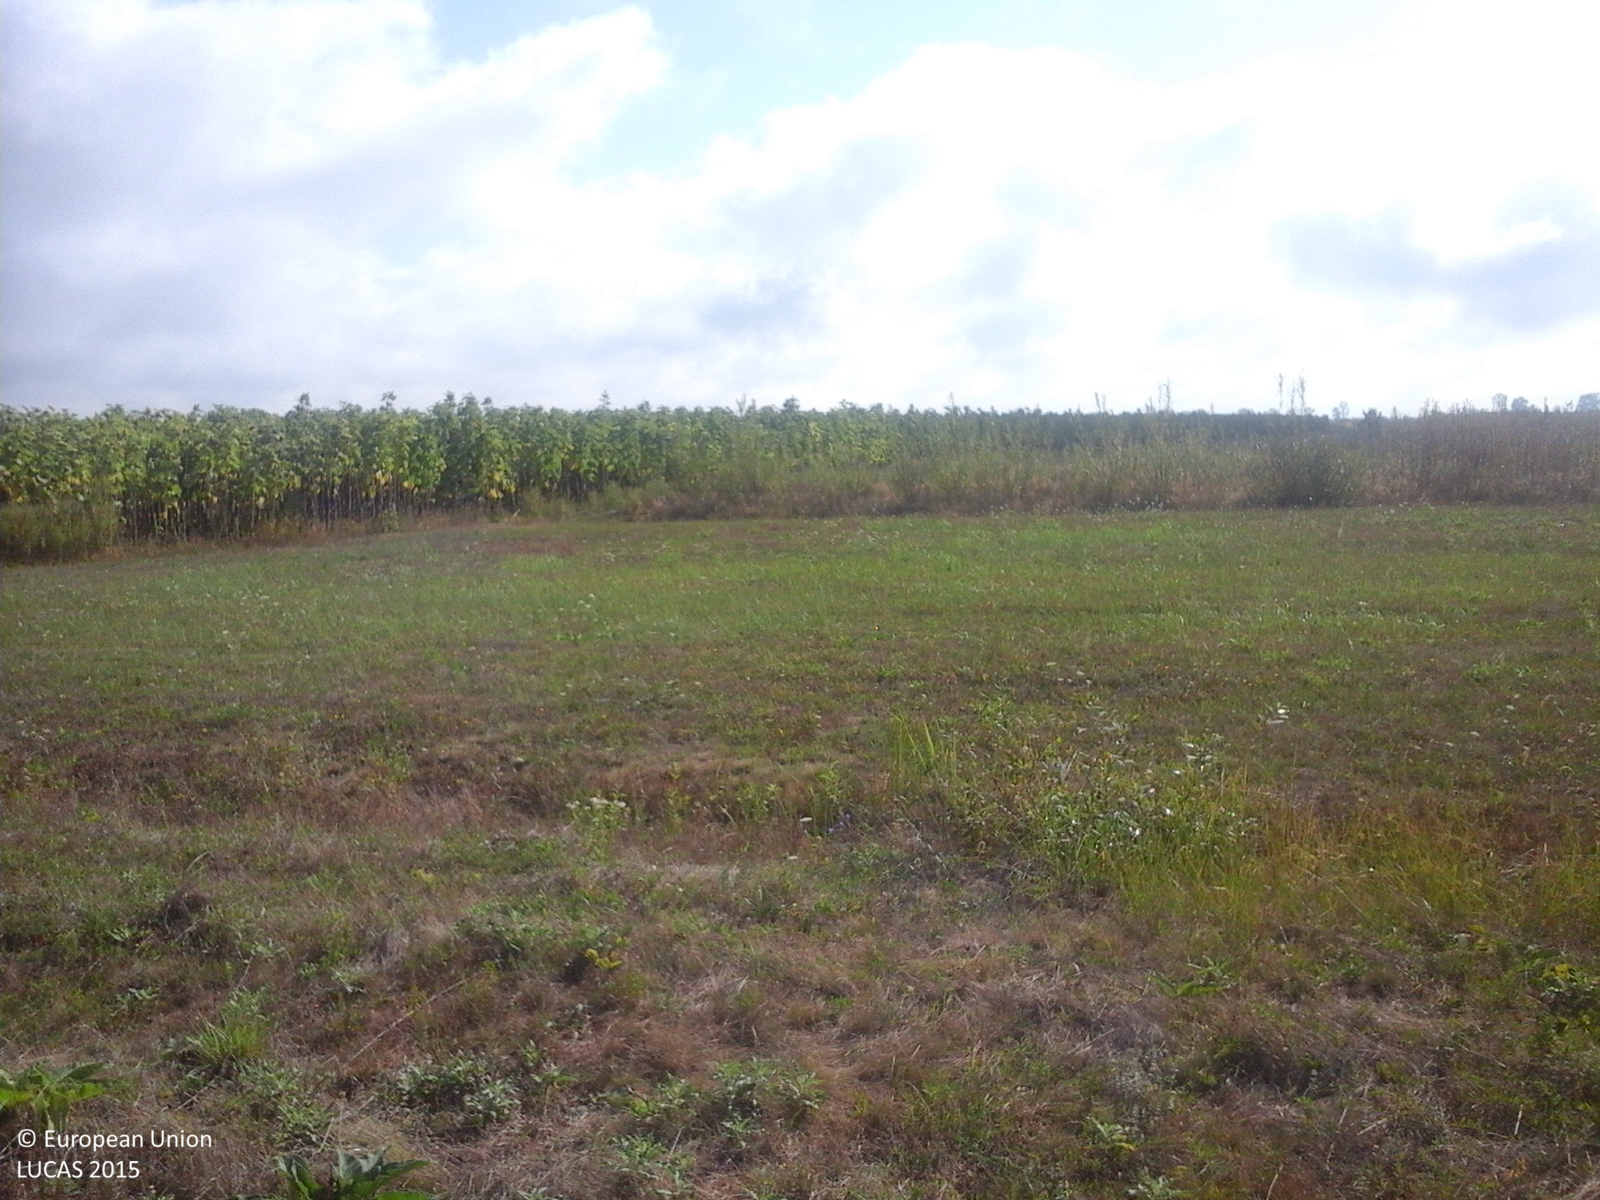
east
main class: Grassland
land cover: Grassland without tree/shrub cover
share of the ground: > 75 %
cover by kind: herbaceous plants 100 %
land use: Agriculture (excluding fallow land and kitchen gardens)
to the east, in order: Grassland without tree/shrub cover; Tracks; Maize; Common wheat; Lucerne; Spontaneously vegetated surfaces; Common wheat
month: September
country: RO
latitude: 47.9643
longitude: 22.9648
